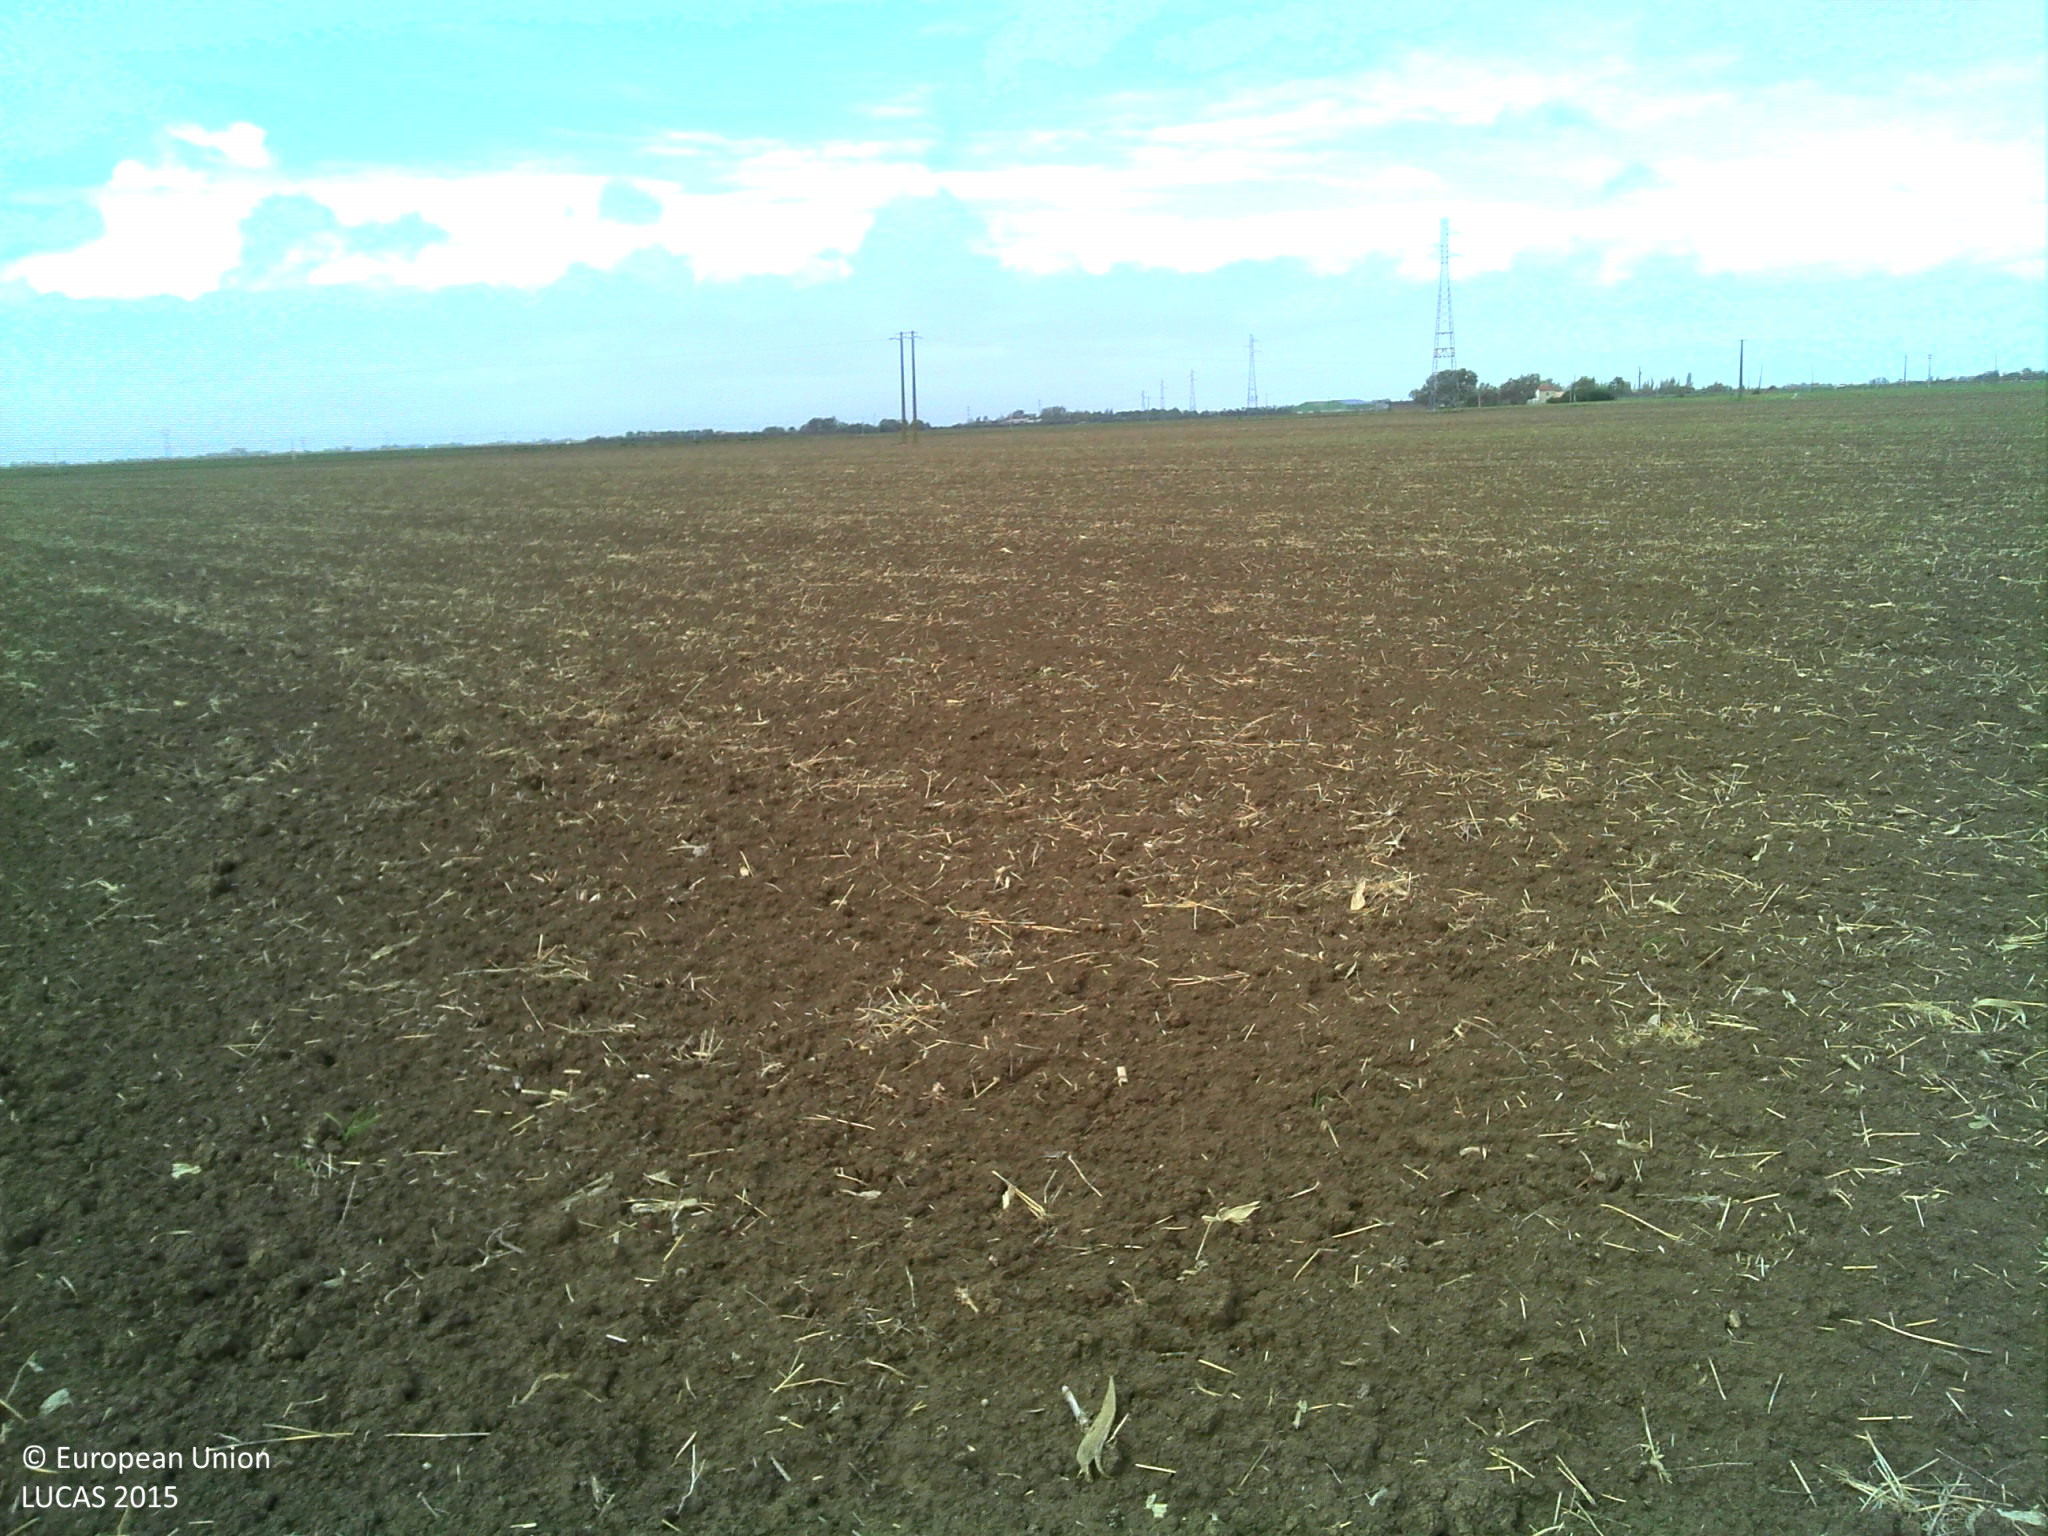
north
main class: Cropland
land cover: Maize
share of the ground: < 10 %
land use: Agriculture (excluding fallow land and kitchen gardens)
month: October
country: FR
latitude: 46.3362
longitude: -1.0877
